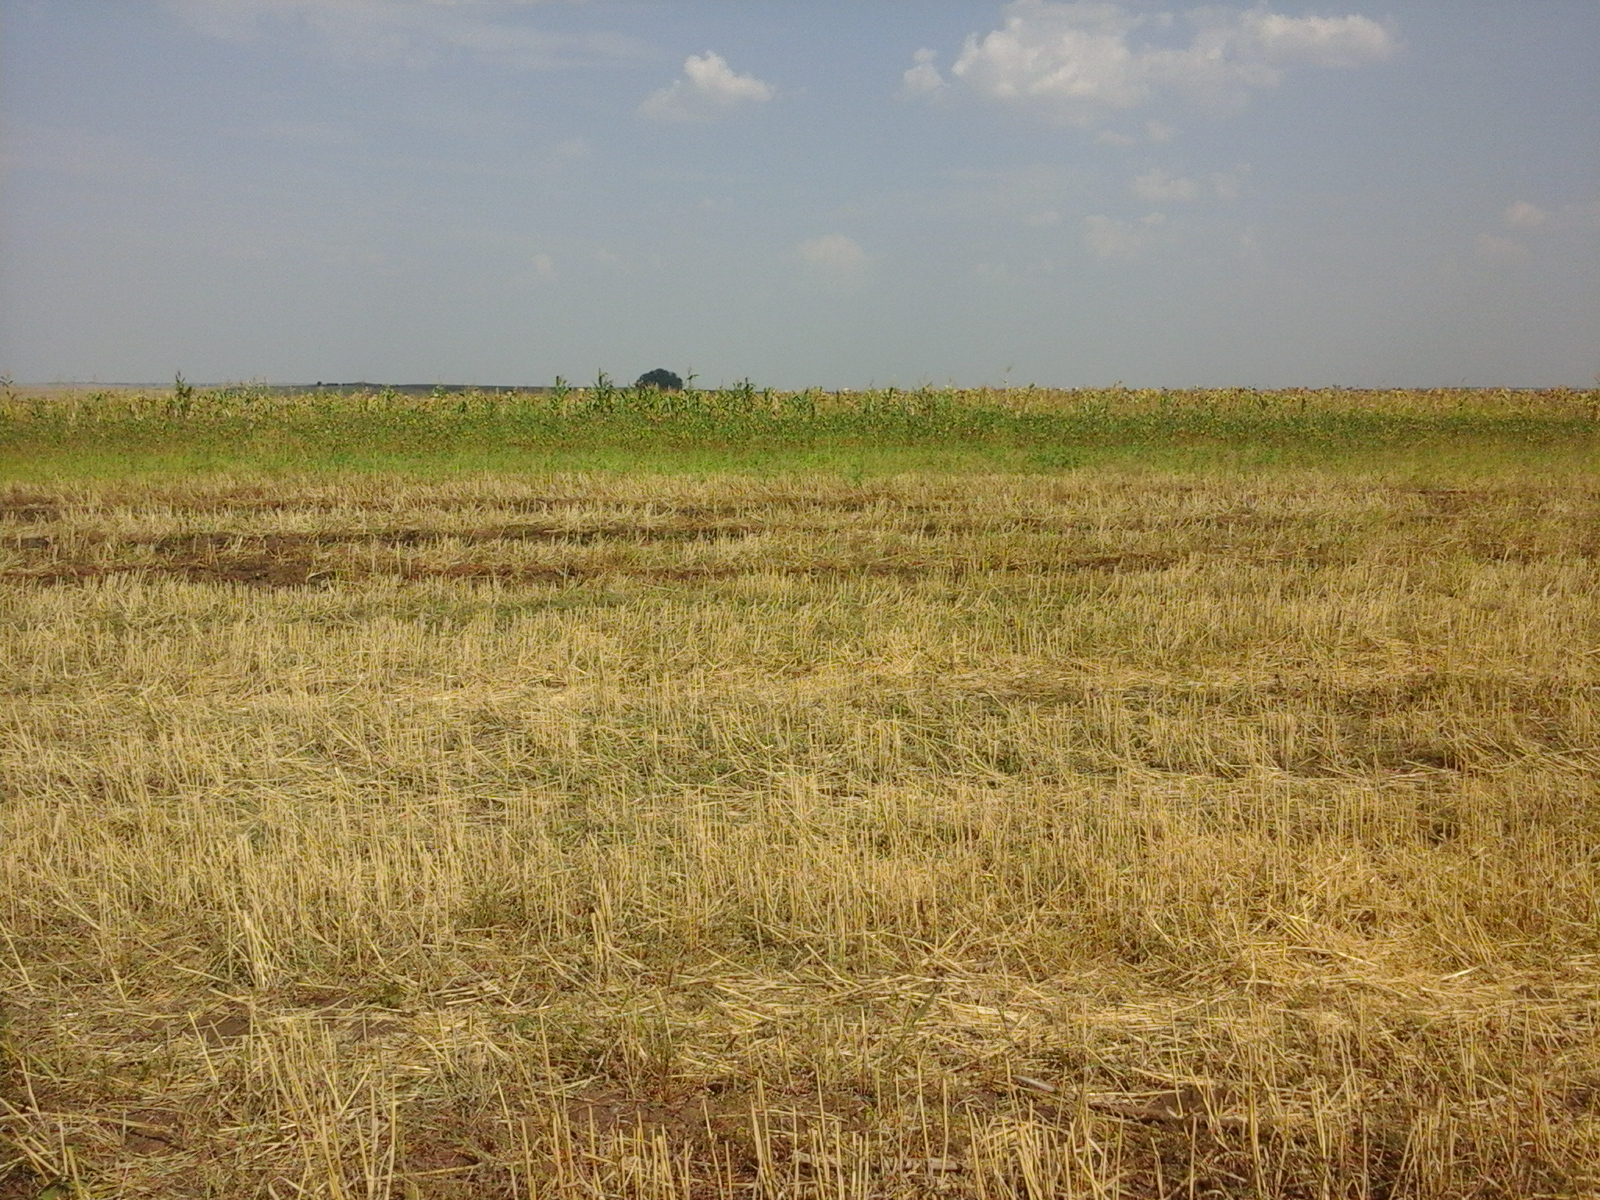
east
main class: Cropland
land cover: Common wheat
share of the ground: > 75 %
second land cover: Spontaneously vegetated surfaces
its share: 25 - 50 %
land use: Agriculture (excluding fallow land and kitchen gardens)
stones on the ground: < 10 %
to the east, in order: Common wheat; Spontaneously vegetated surfaces; Sunflower; Grassland without tree/shrub cover; Maize; Sunflower; Maize; Common wheat; Spontaneously vegetated surfaces; Tracks; Grass margins; Common wheat; Spontaneously vegetated surfaces; Common wheat; Spontaneously vegetated surfaces; Common wheat; Grassland without tree/shrub cover; Maize
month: August
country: RO
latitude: 44.0960
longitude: 23.5536
